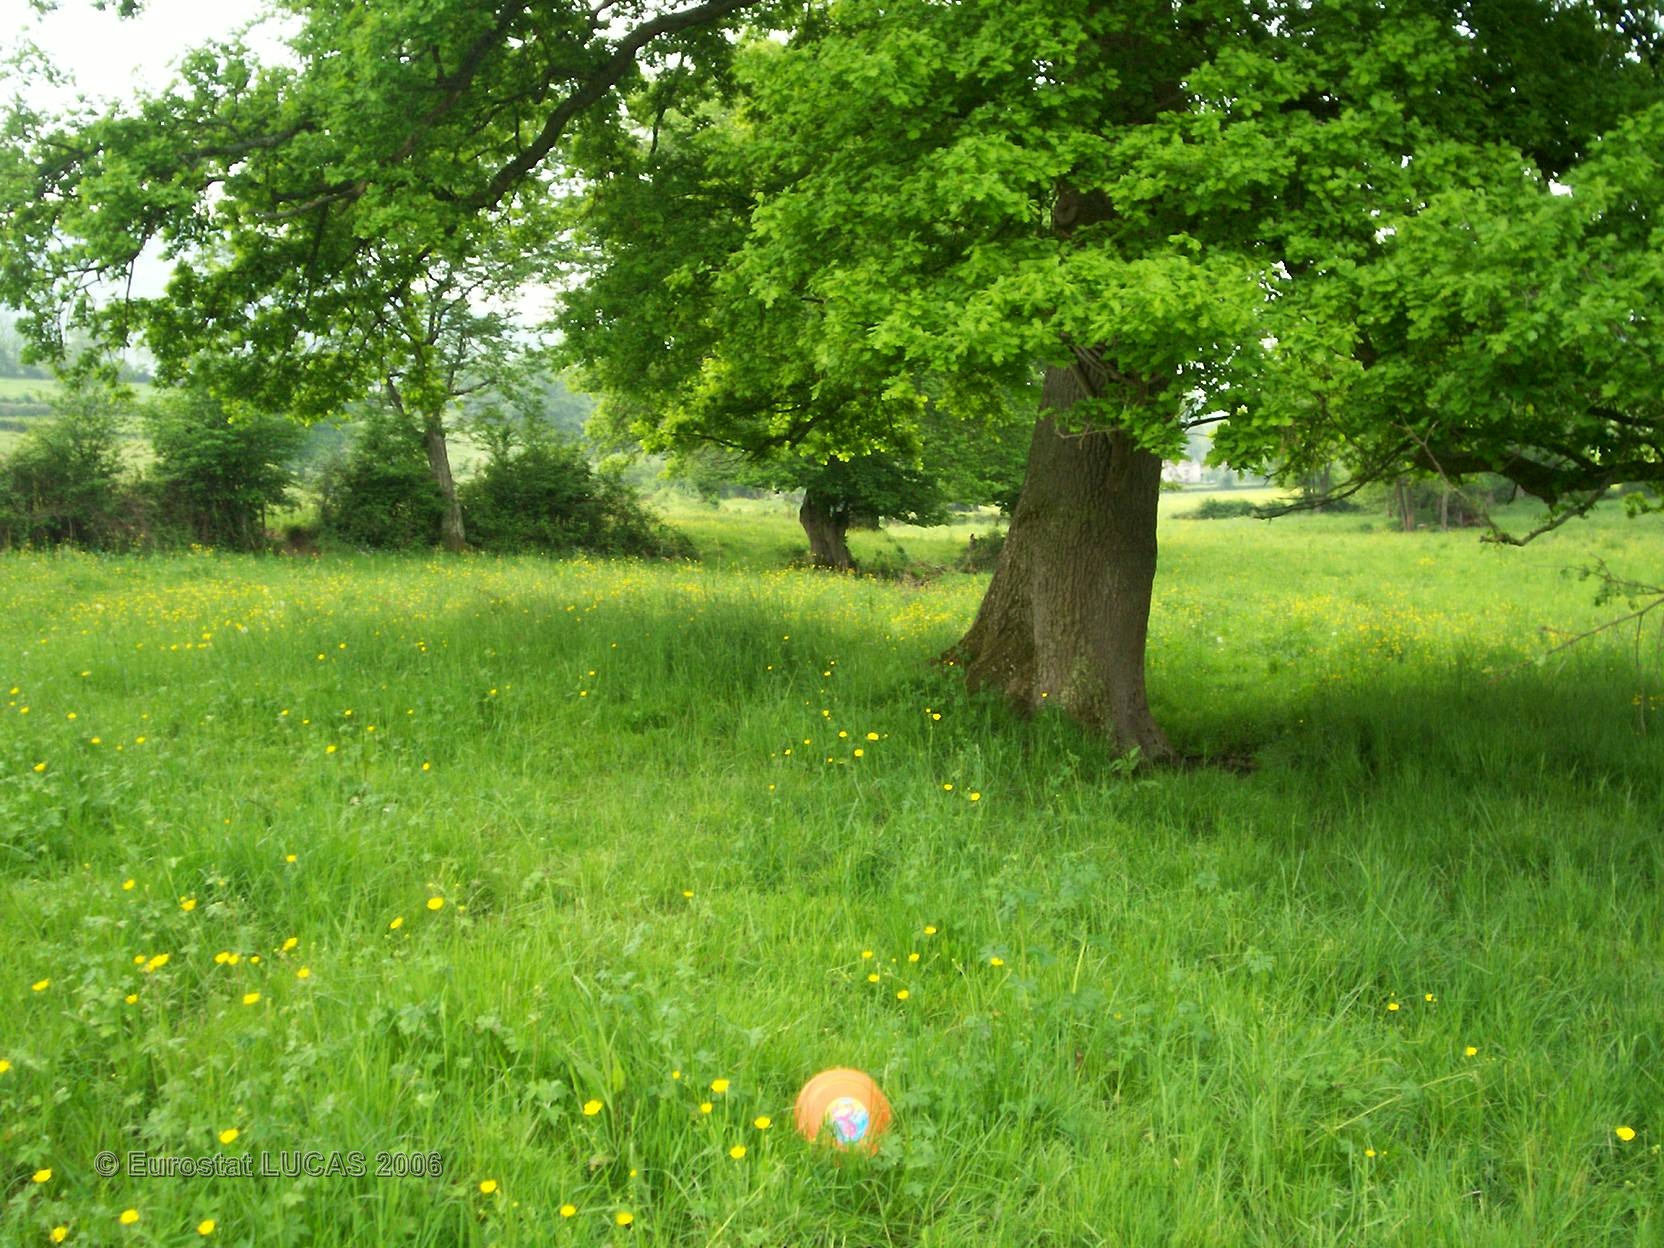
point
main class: Grassland
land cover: Grassland with sparse tree/shrub cover
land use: Agriculture (excluding fallow land and kitchen gardens)
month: May
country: FR
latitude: 46.5110
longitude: 4.7495
